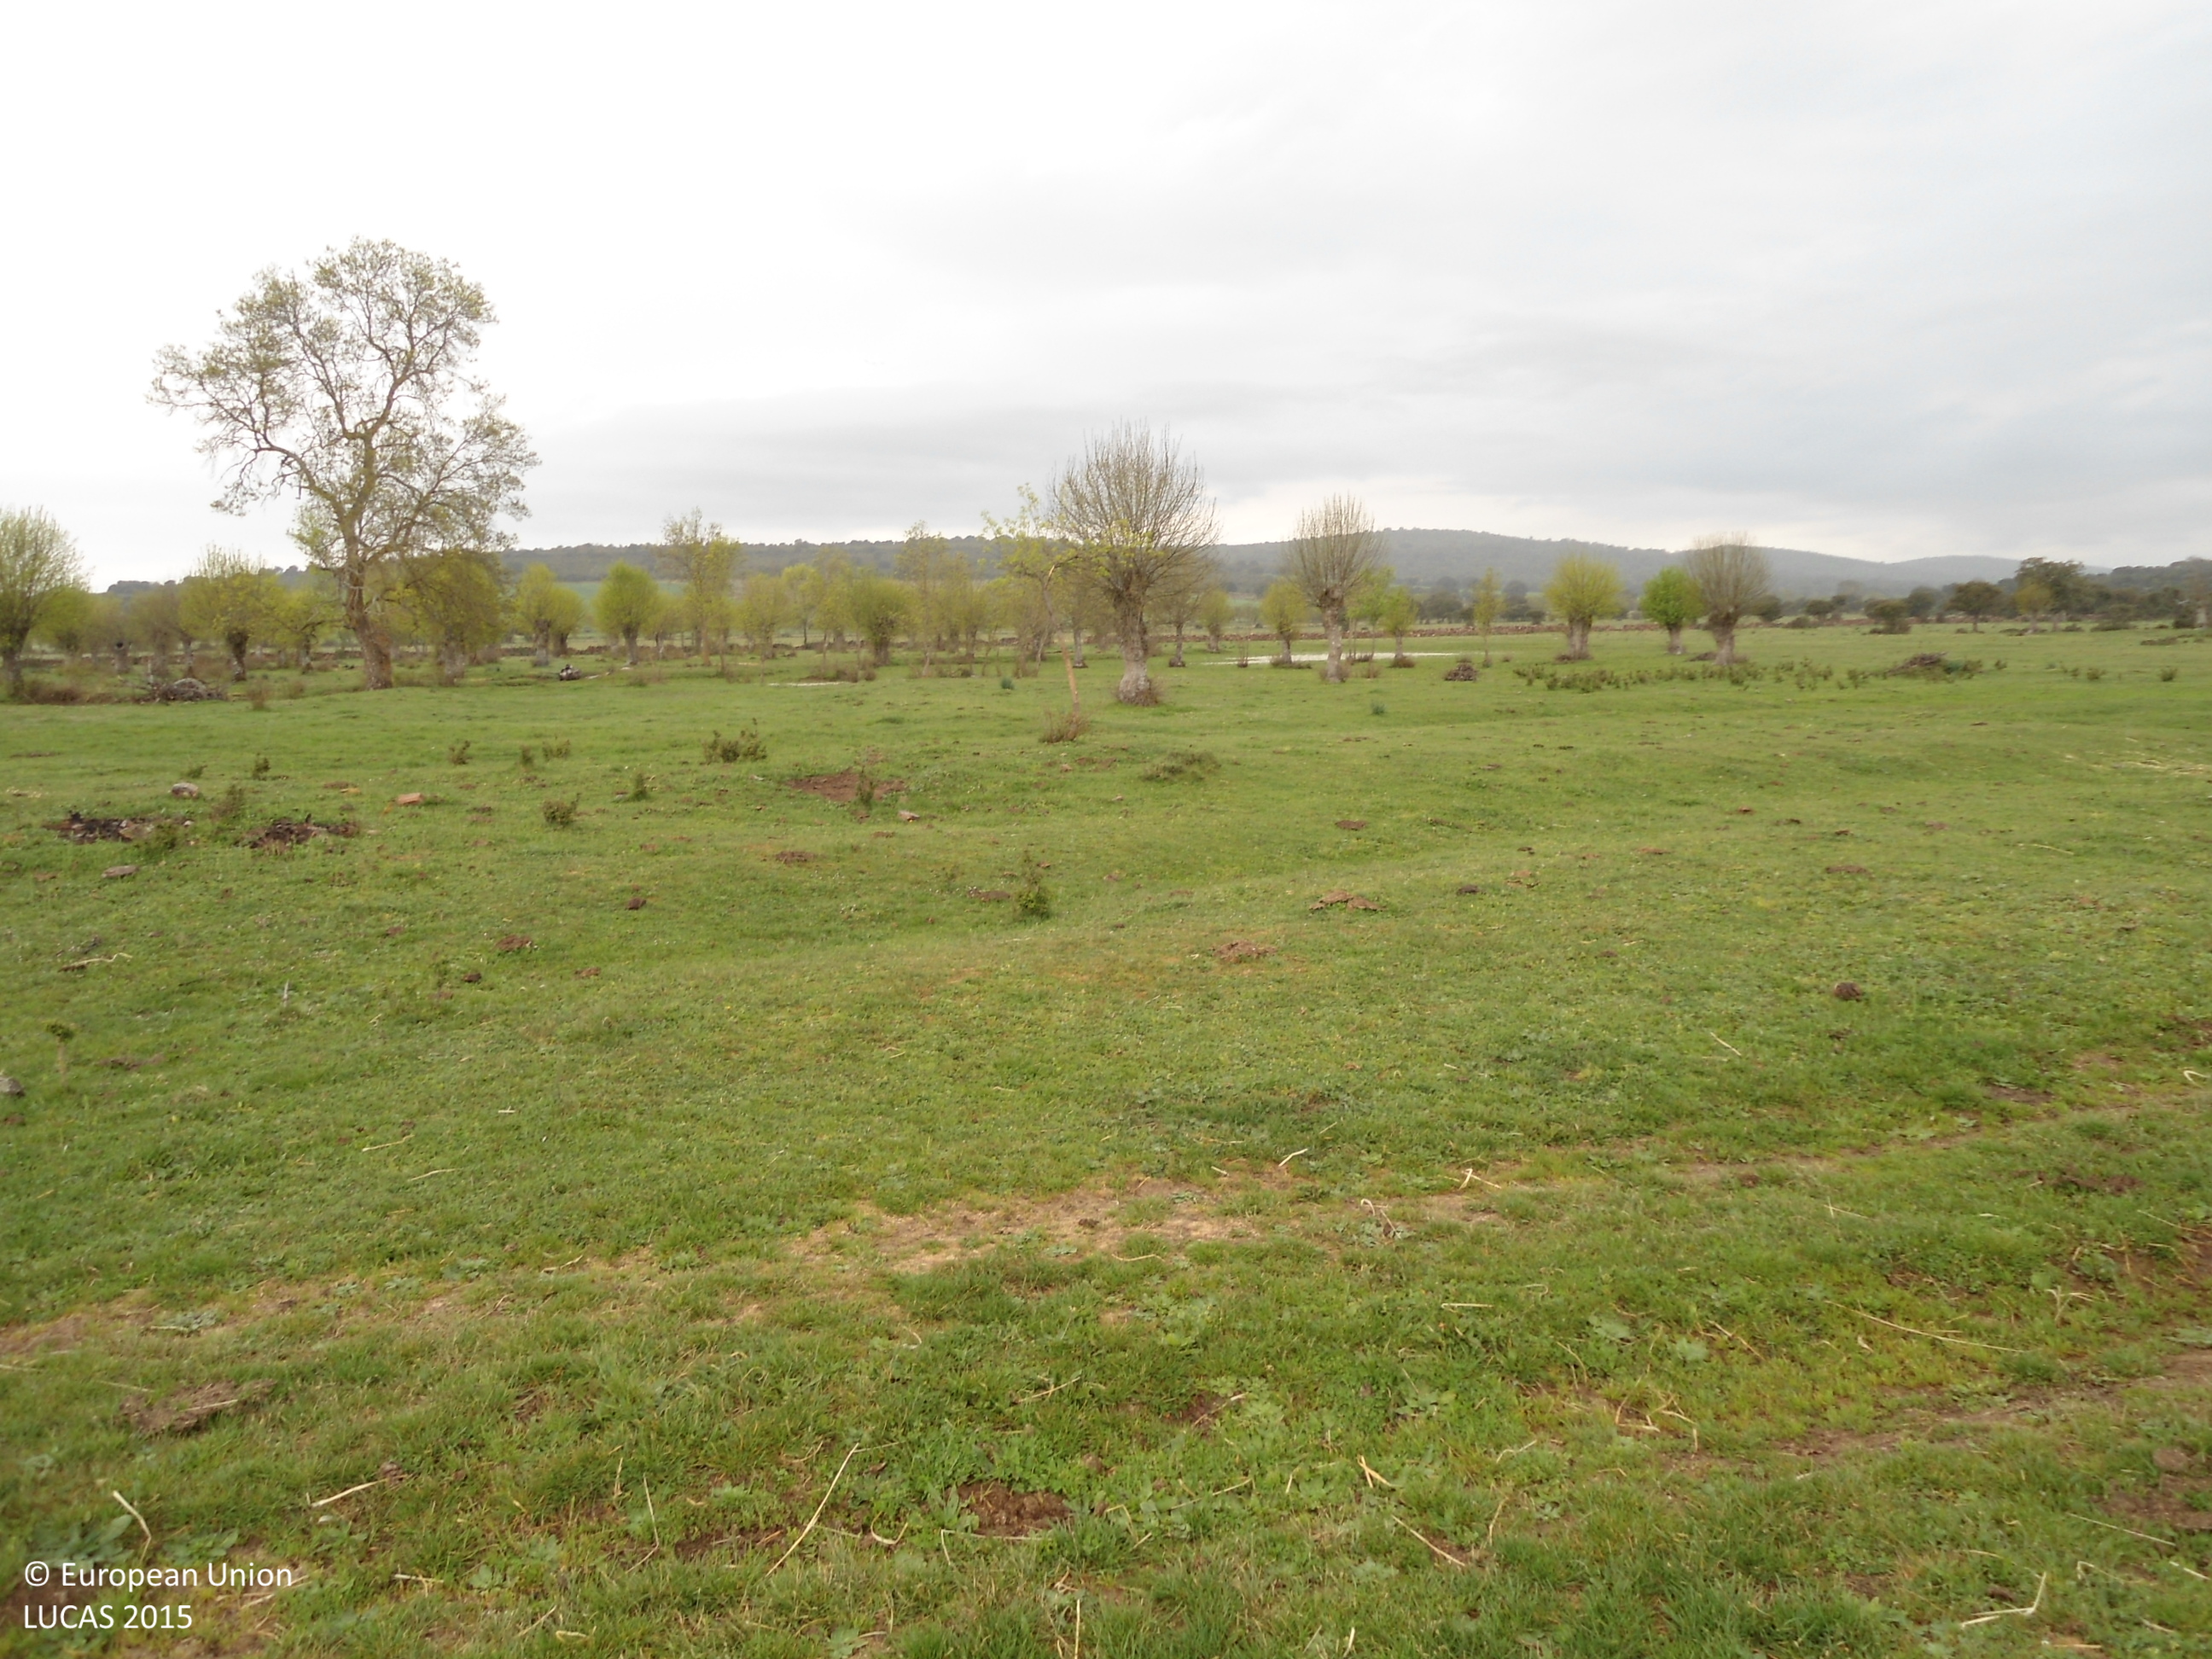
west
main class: Grassland
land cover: Grassland without tree/shrub cover
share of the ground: > 75 %
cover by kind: herbaceous plants 100 %
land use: Agriculture (excluding fallow land and kitchen gardens)
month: April
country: ES
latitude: 41.7510
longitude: -5.9320
